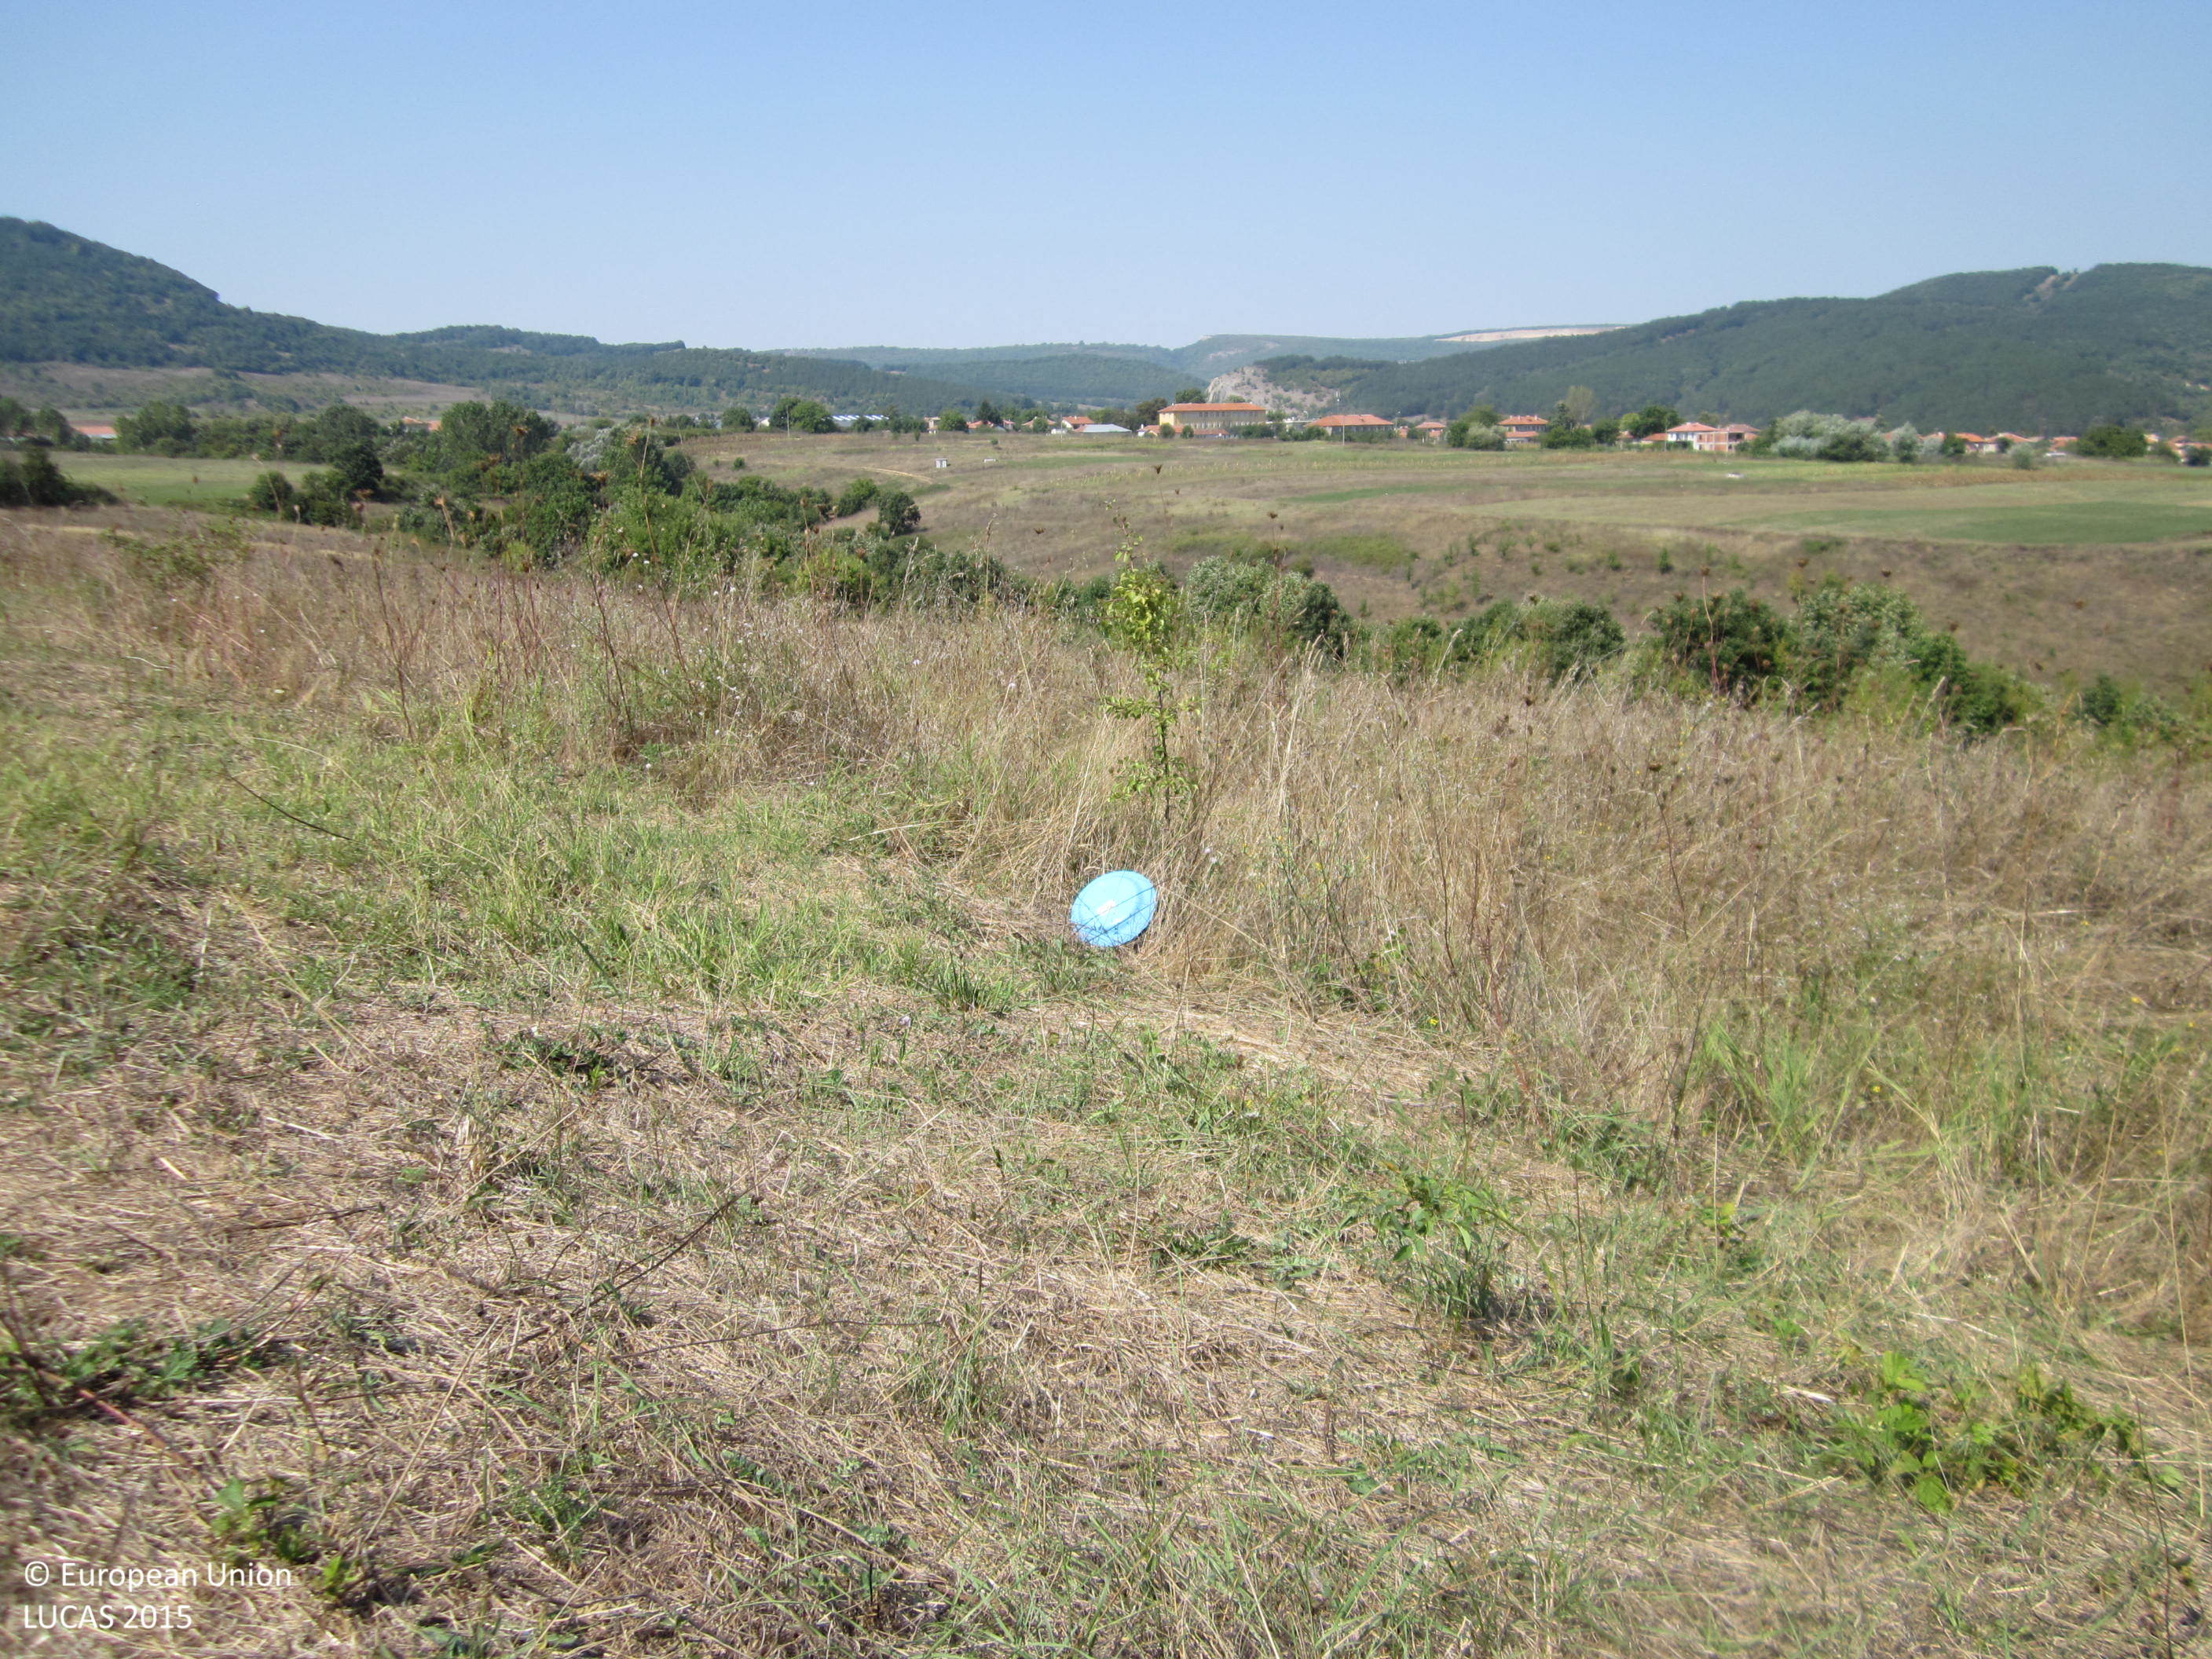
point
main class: Grassland
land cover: Grassland with sparse tree/shrub cover
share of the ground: > 75 %
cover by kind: herbaceous plants 90 %, broadleaved forest trees 5 %, shrubs 5 %
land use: Agriculture (excluding fallow land and kitchen gardens)
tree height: < 5 m
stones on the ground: < 10 %
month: September
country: BG
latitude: 42.9362
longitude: 27.2103
